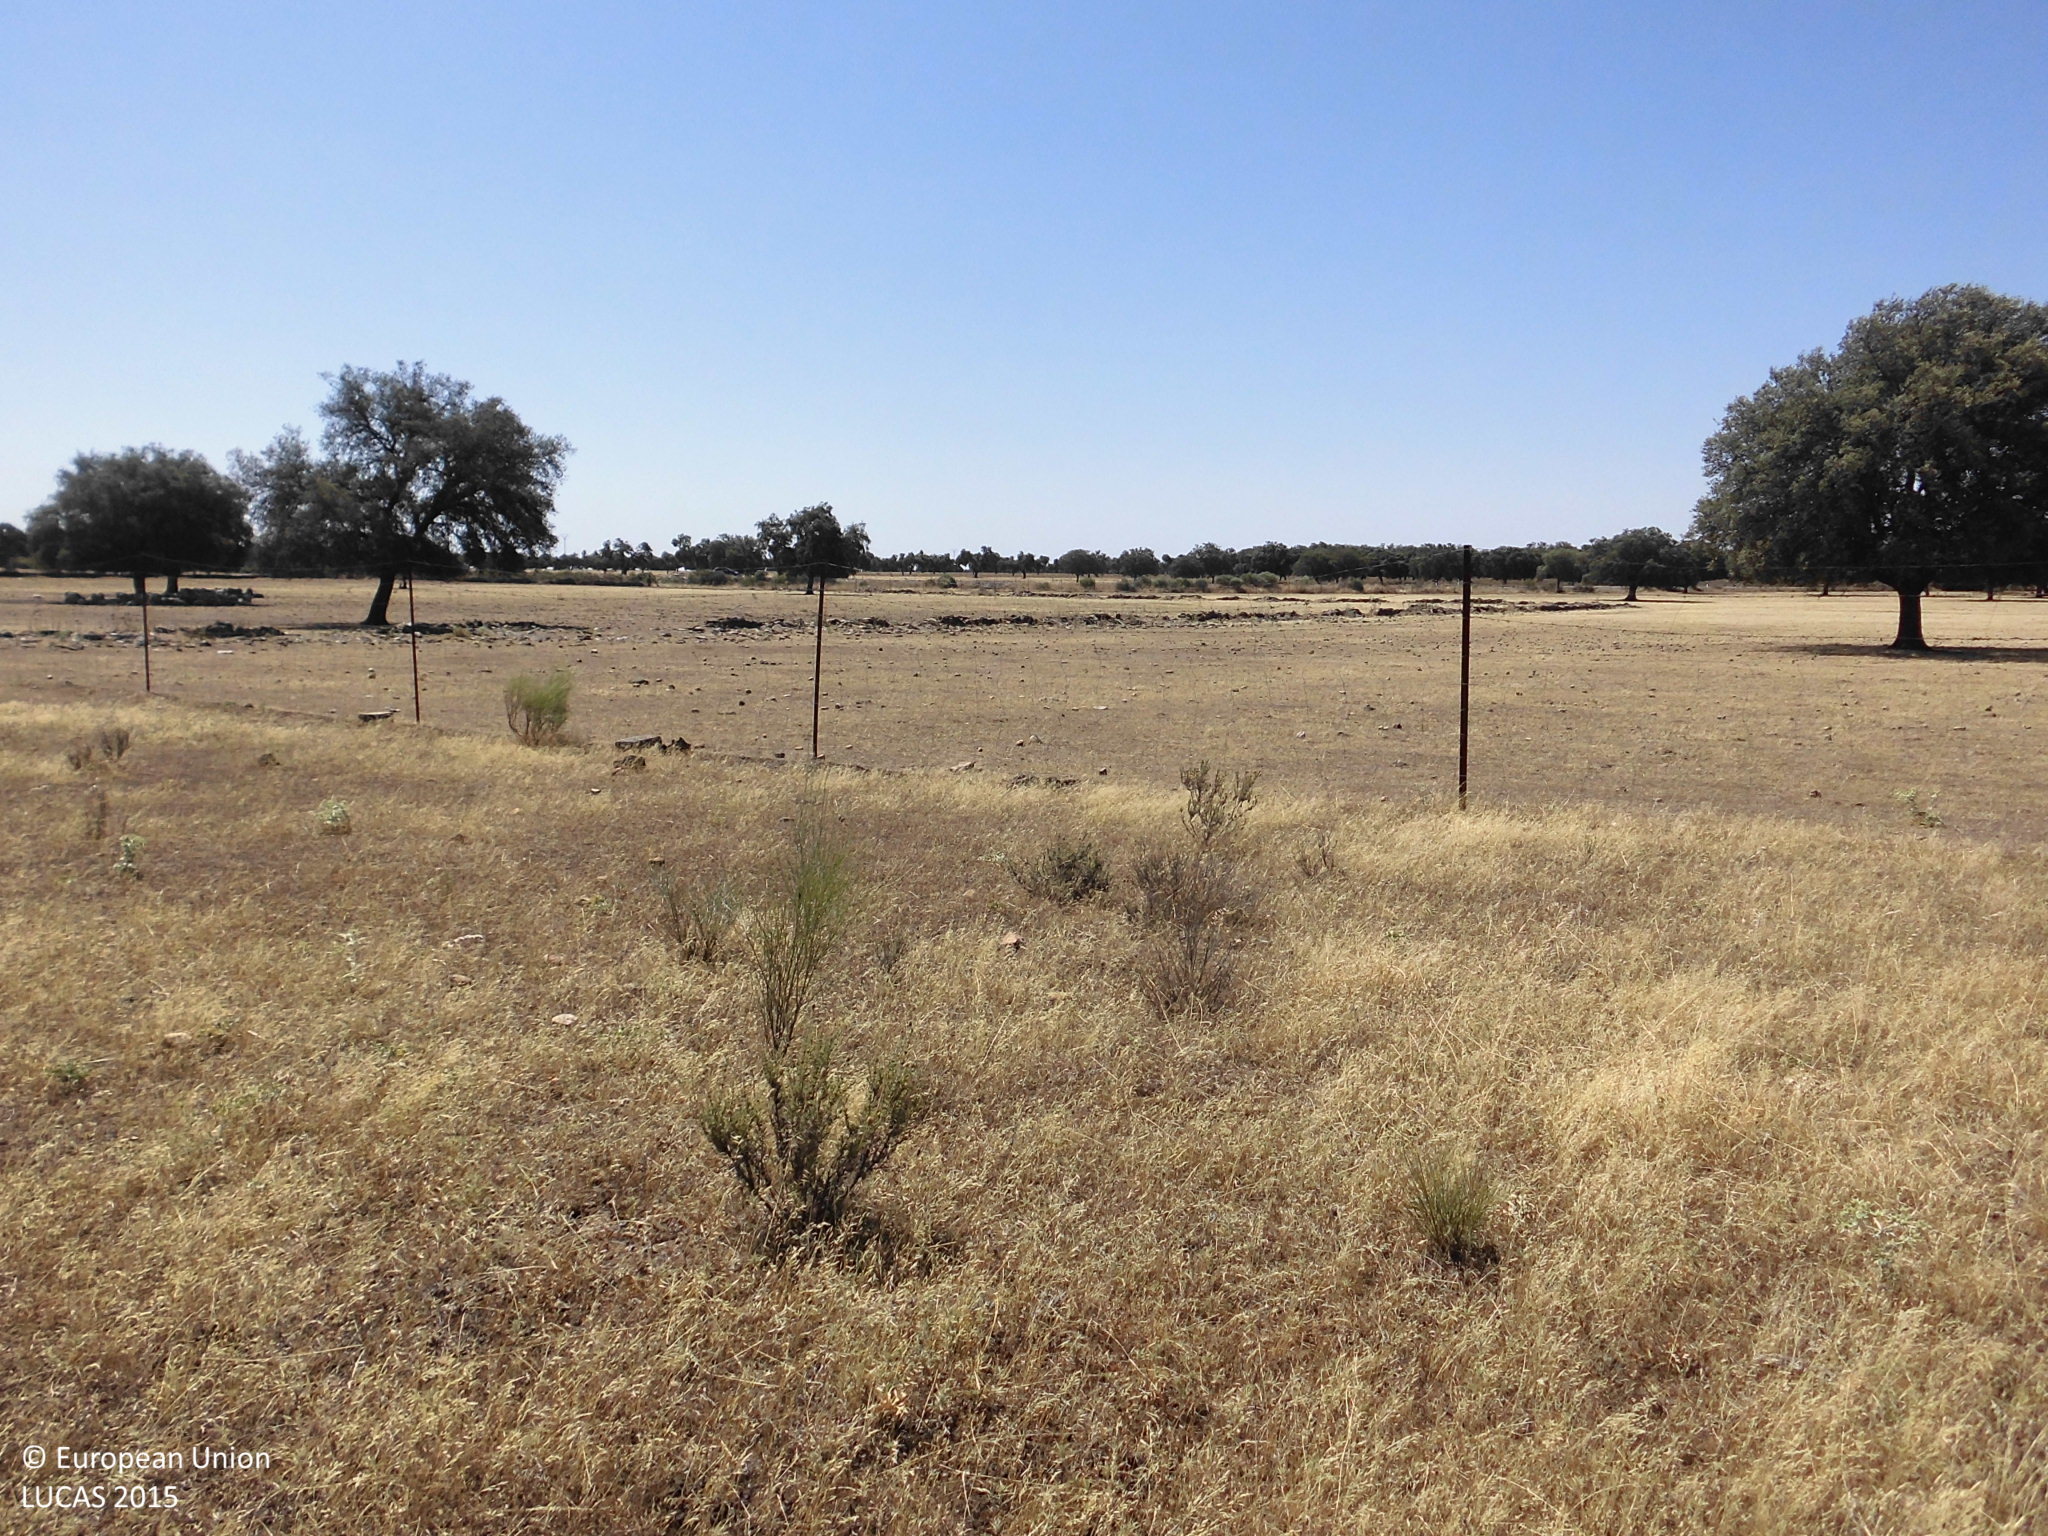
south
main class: Grassland
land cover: Grassland without tree/shrub cover
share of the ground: > 75 %
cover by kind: herbaceous plants 100 %
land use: Agriculture (excluding fallow land and kitchen gardens)
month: June
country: ES
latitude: 39.7056
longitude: -5.9609
